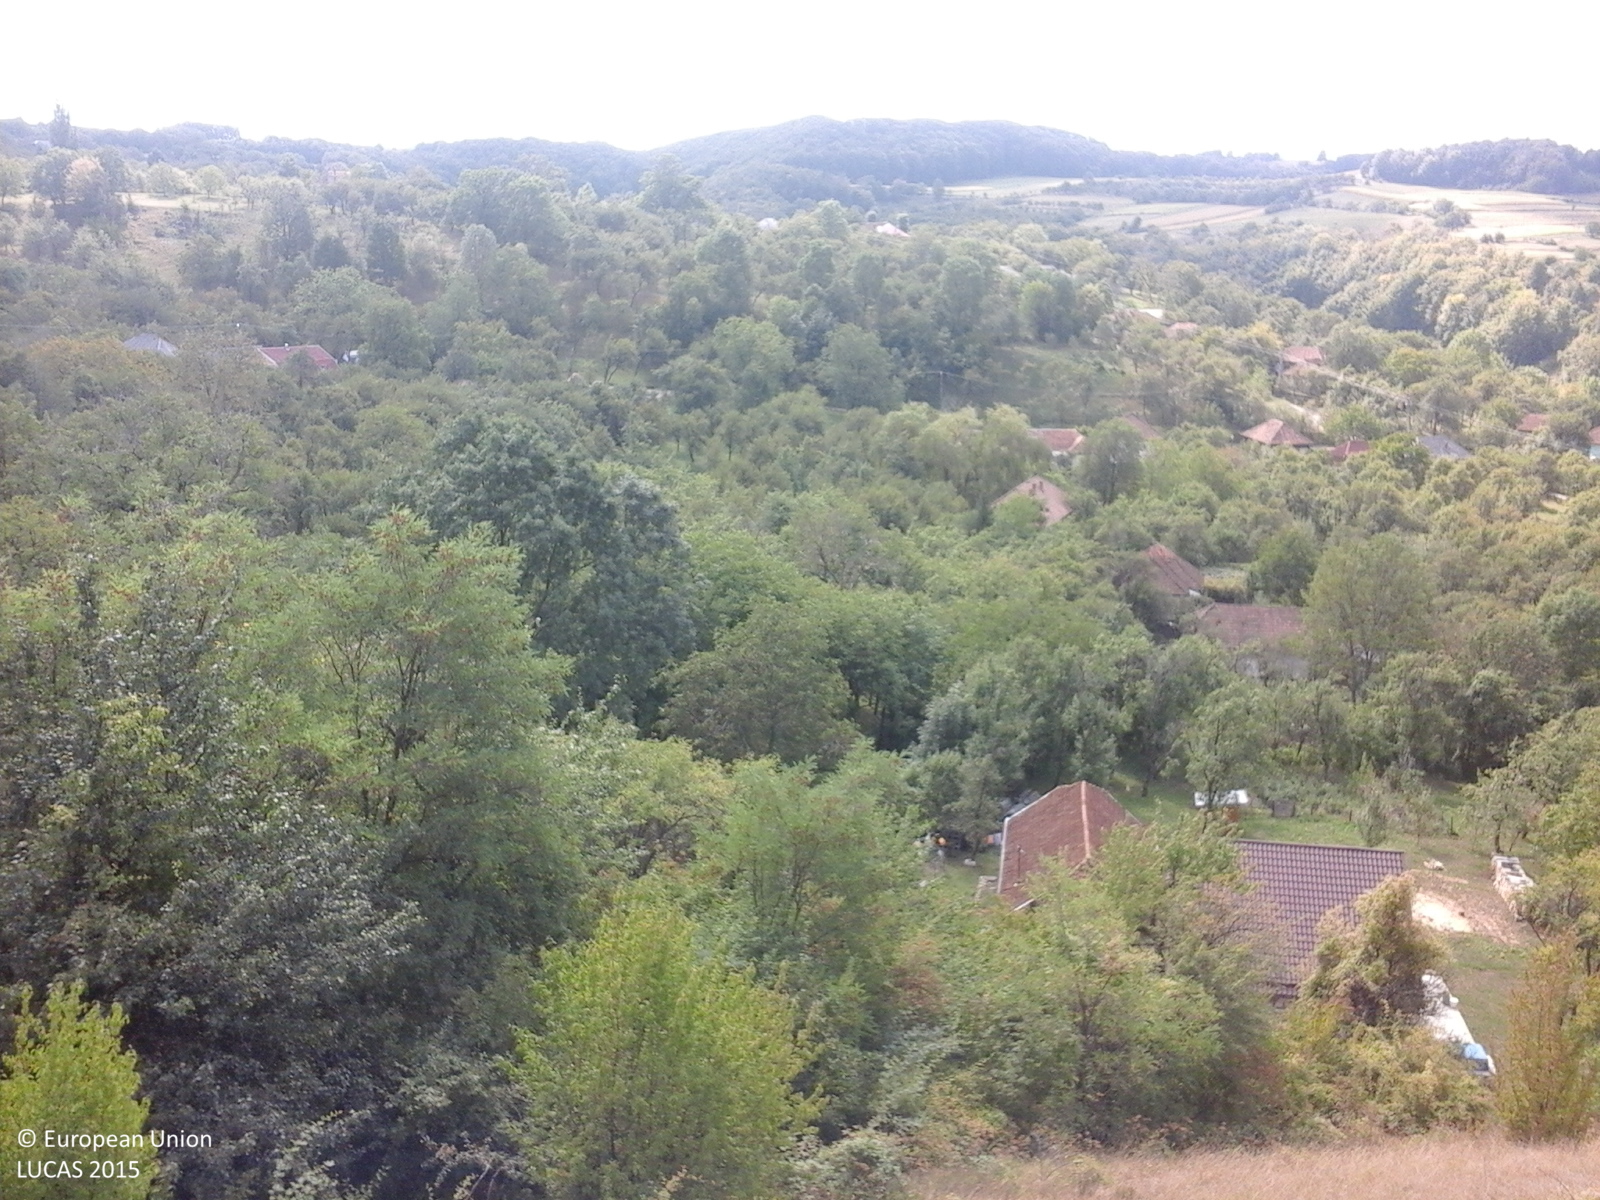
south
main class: Grassland
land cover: Grassland with sparse tree/shrub cover
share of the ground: > 75 %
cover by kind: herbaceous plants 85 %, shrubs 10 %, broadleaved forest trees 5 %
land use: Agriculture (excluding fallow land and kitchen gardens)
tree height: < 5 m
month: September
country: RO
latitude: 47.4600
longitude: 23.5114
